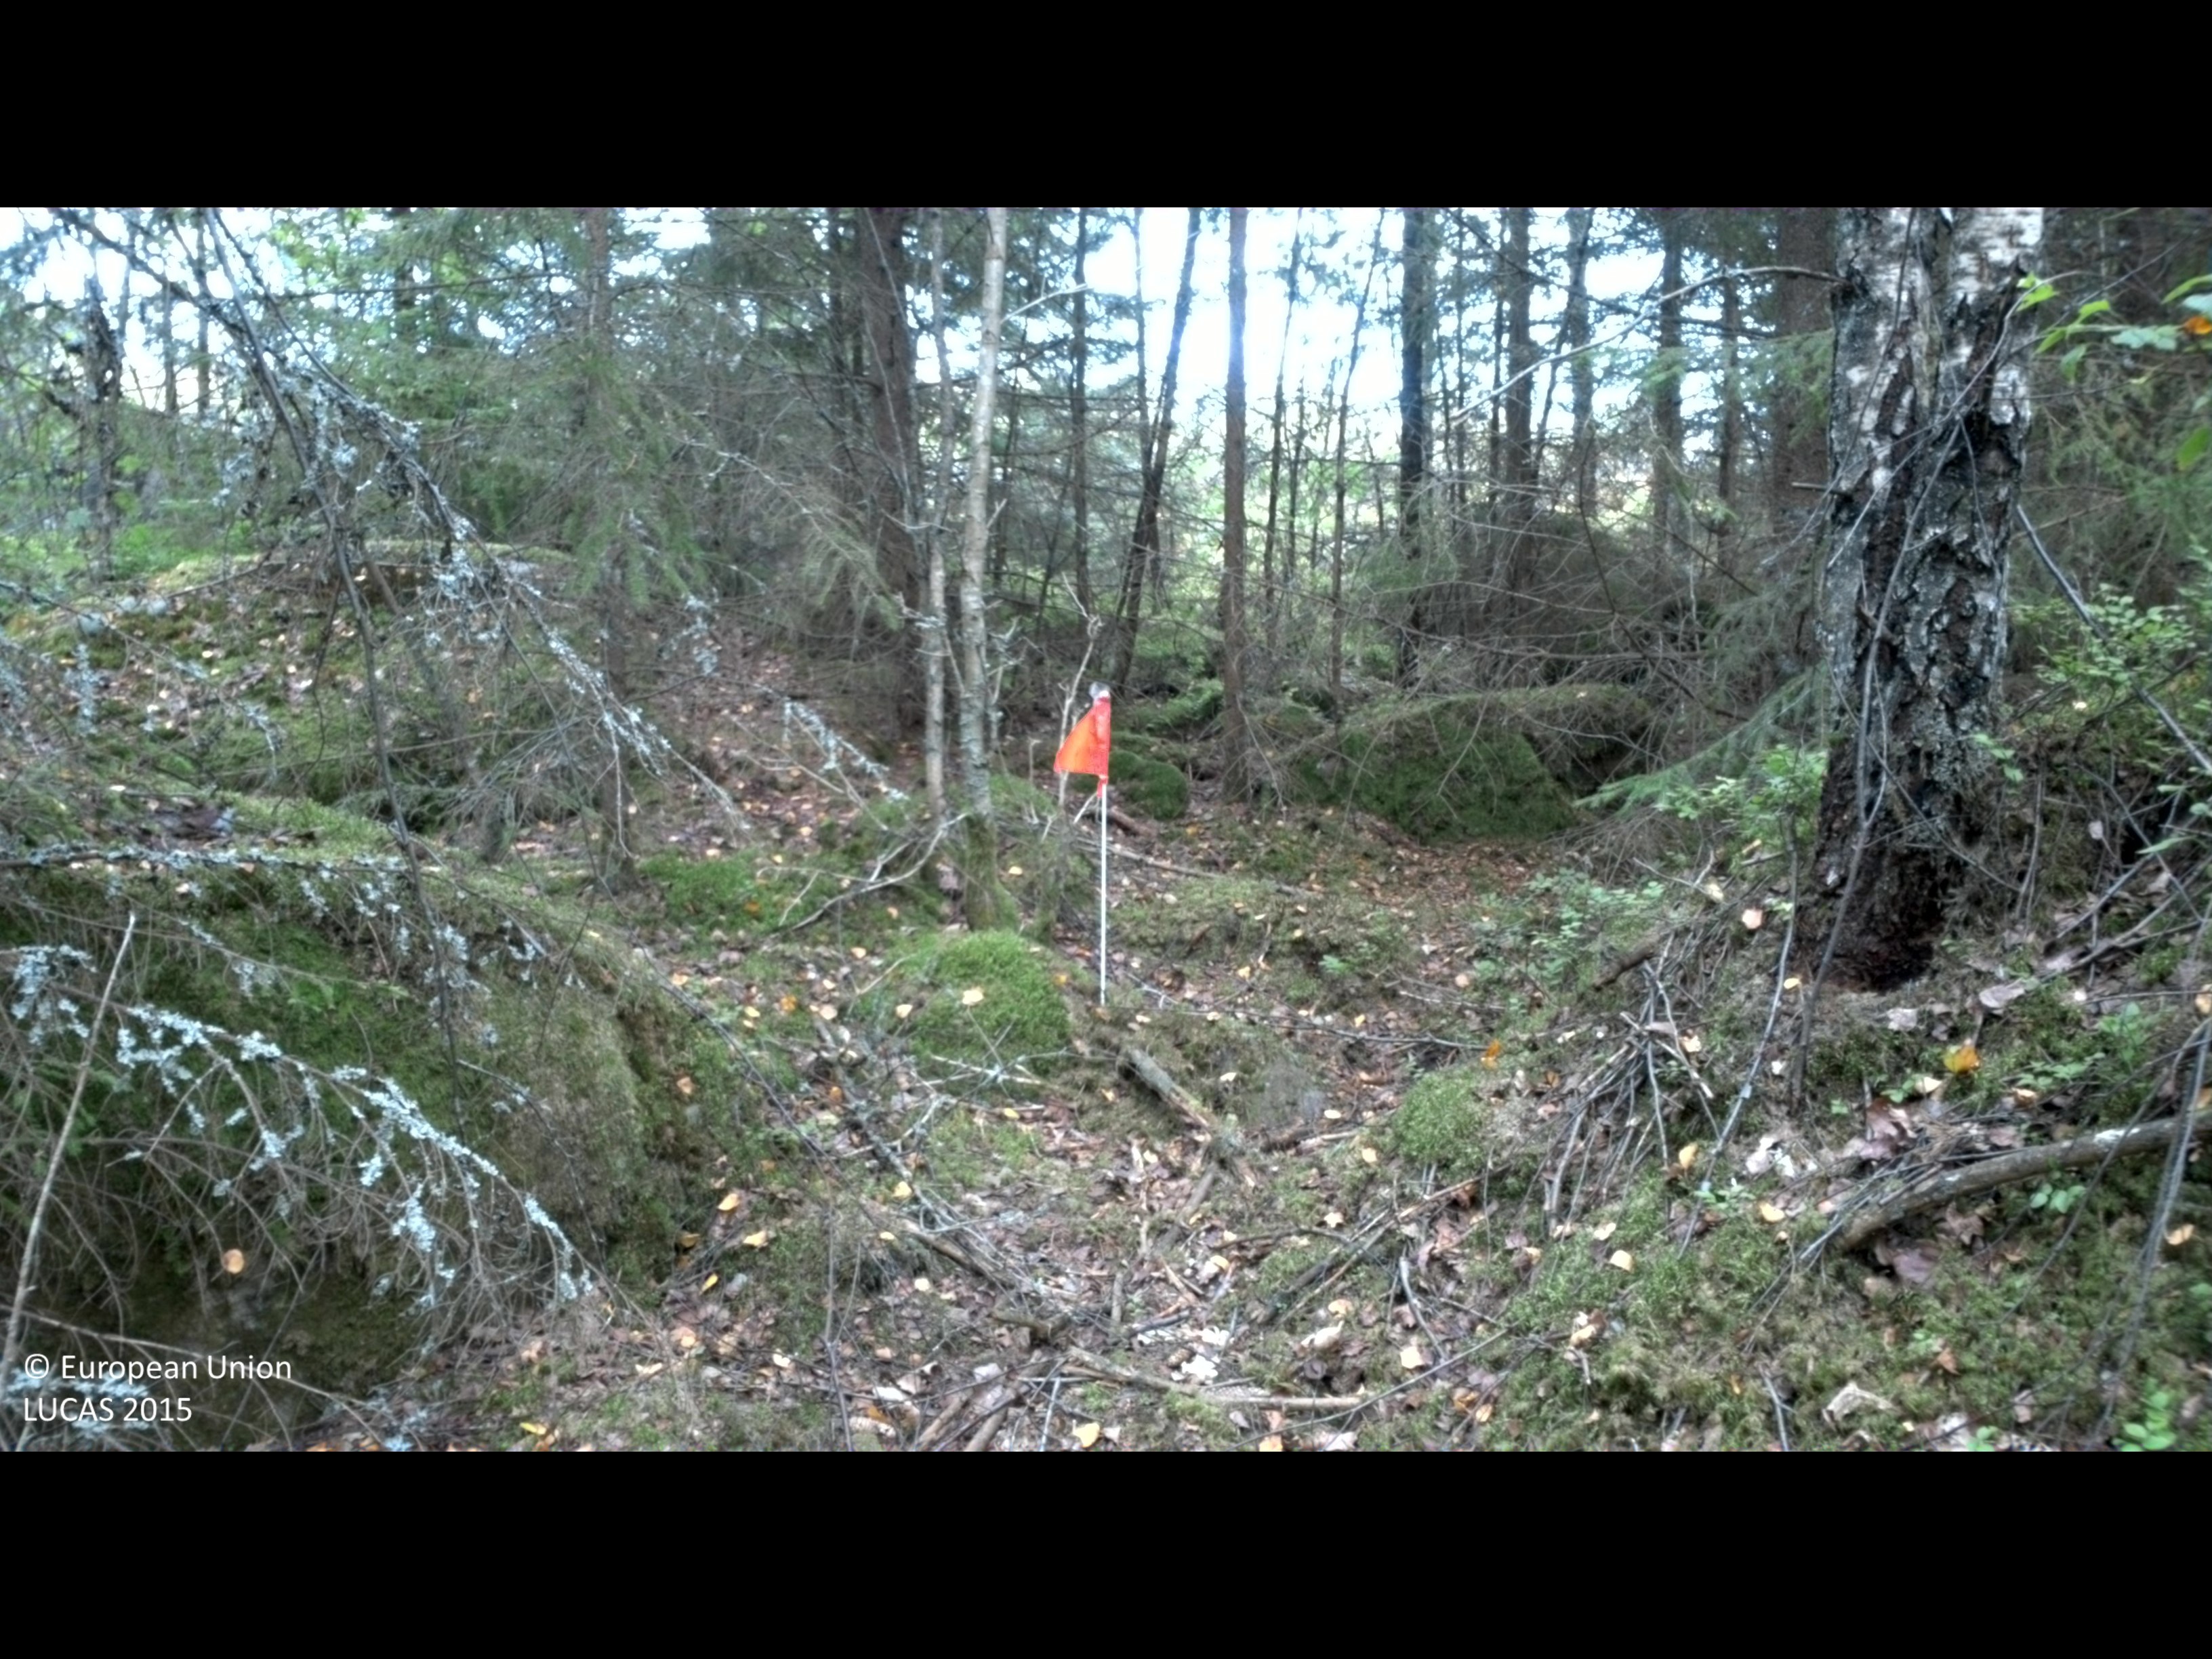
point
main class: Woodland
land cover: Spruce dominated mixed woodland
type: boreal forest
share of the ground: > 75 %
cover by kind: coniferous forest trees 55 %, broadleaved forest trees 25 %, lichens and mosses 20 %
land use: Forestry
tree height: > 5 m
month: August
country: SE
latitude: 56.3235
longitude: 15.0274
